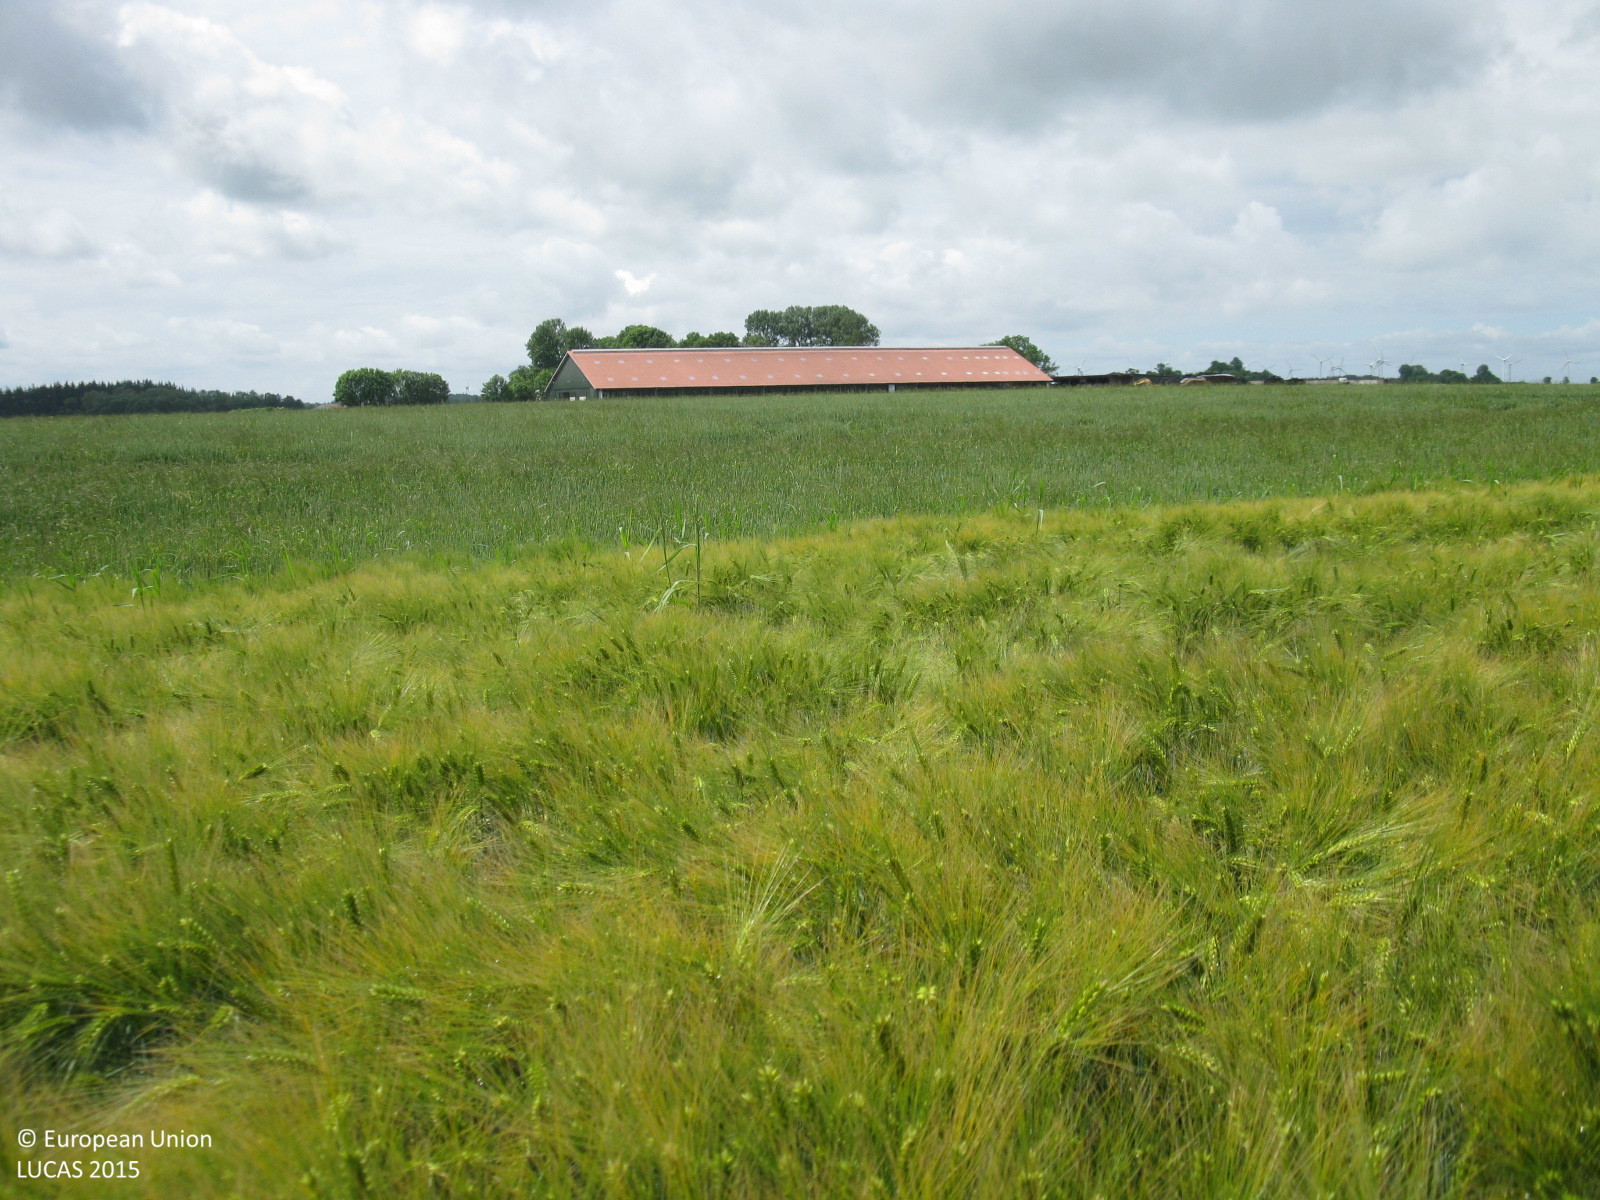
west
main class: Cropland
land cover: Common wheat
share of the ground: > 75 %
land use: Agriculture (excluding fallow land and kitchen gardens)
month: June
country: DE
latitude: 53.6242
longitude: 7.3245
